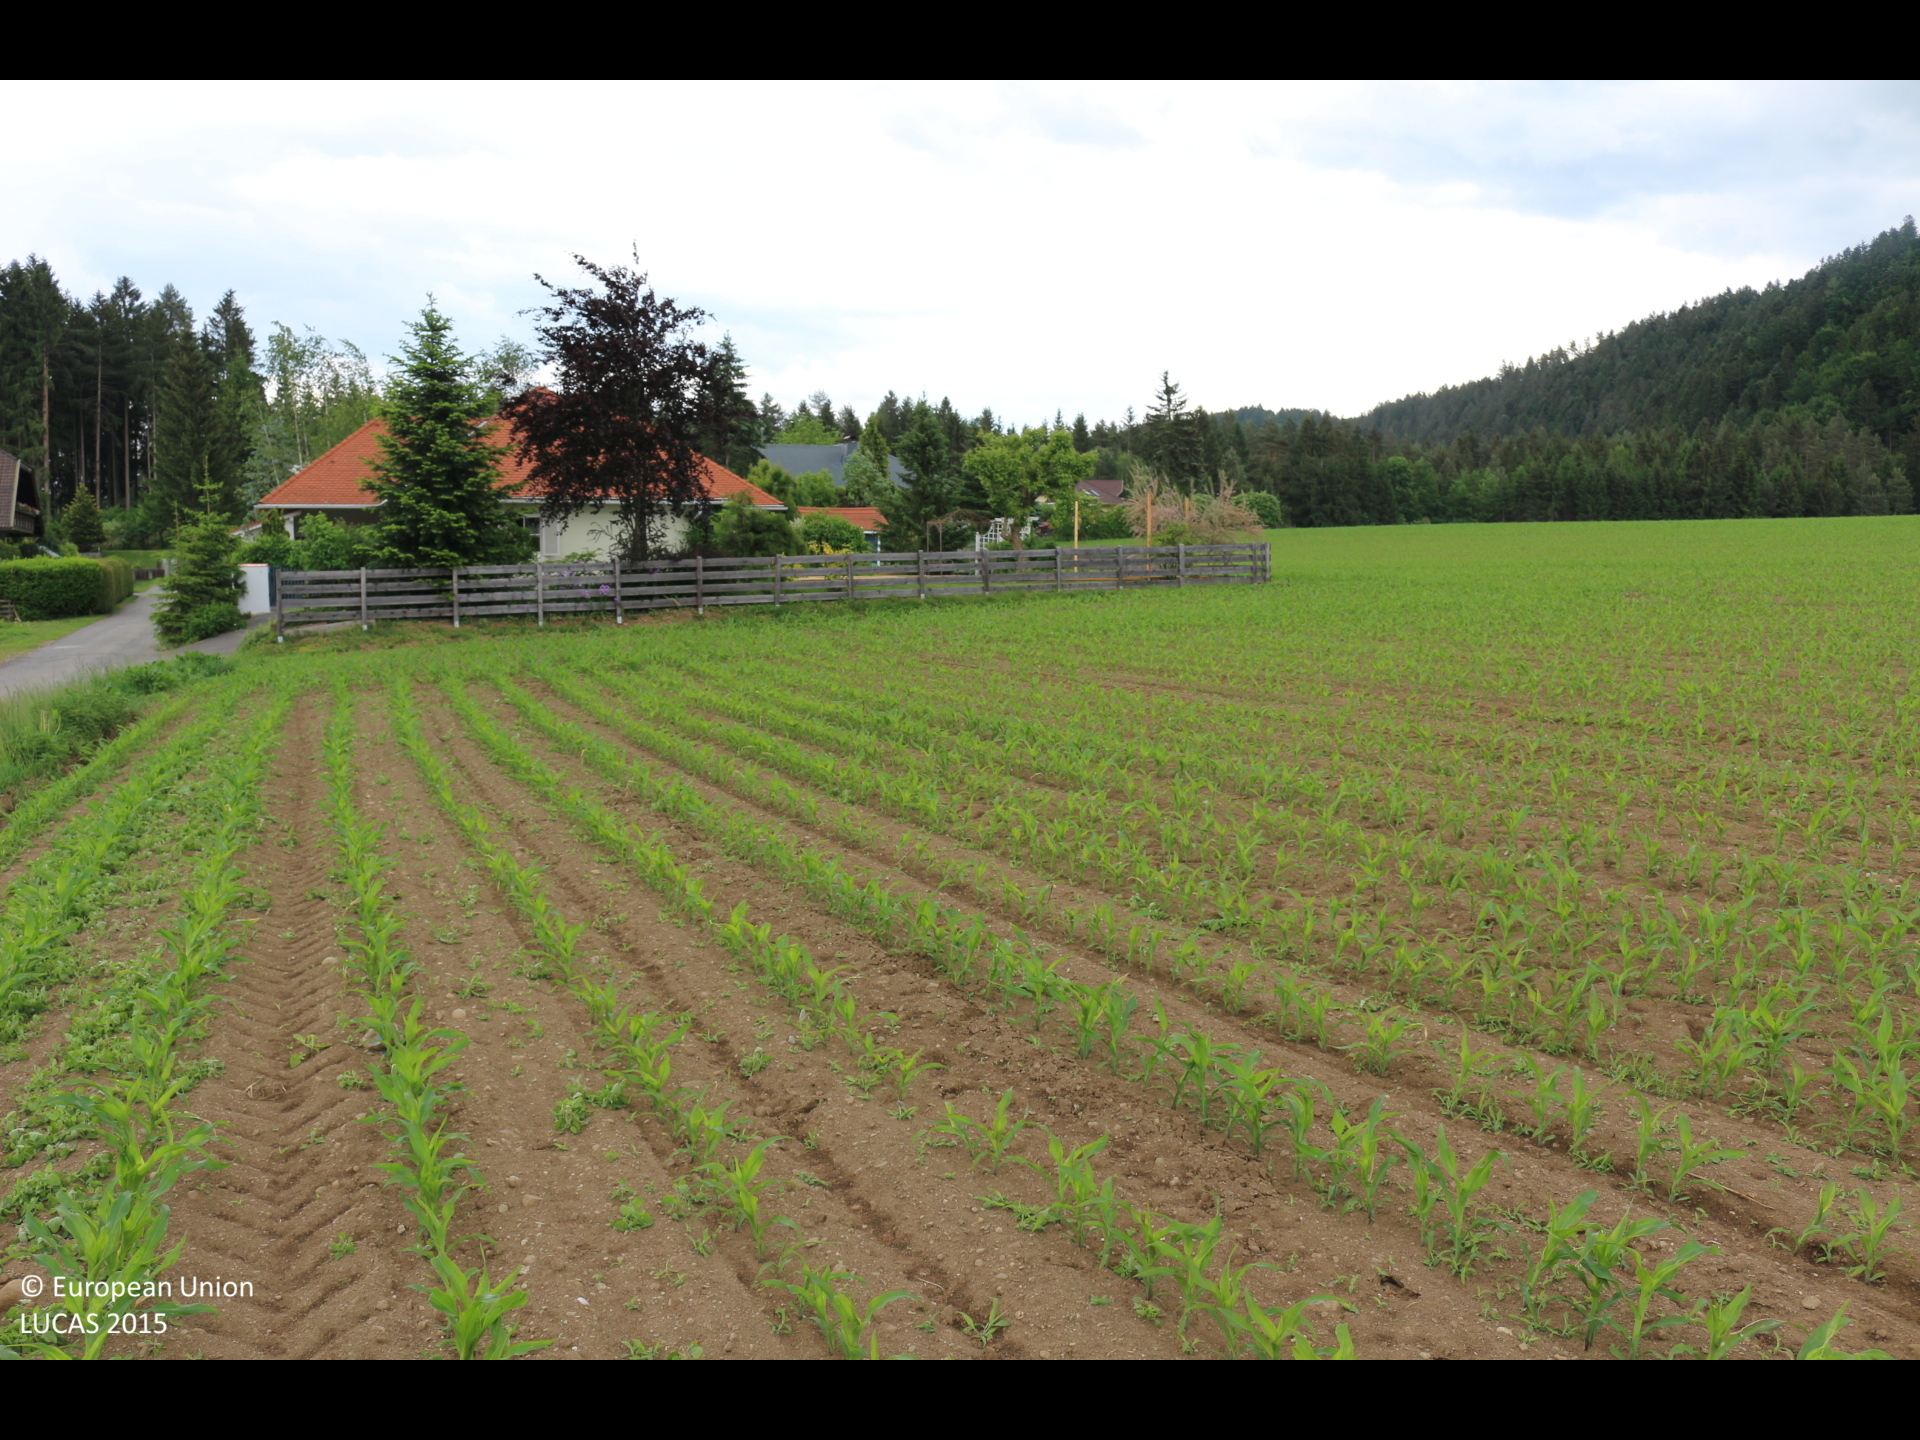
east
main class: Cropland
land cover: Maize
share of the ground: < 10 %
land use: Agriculture (excluding fallow land and kitchen gardens)
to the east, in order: Maize; Artificial constructions in urban areas; Maize; Artificial constructions in urban areas; Grassland without tree/shrub cover; Other mixed woodland
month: May
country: AT
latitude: 46.7187
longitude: 14.2233
